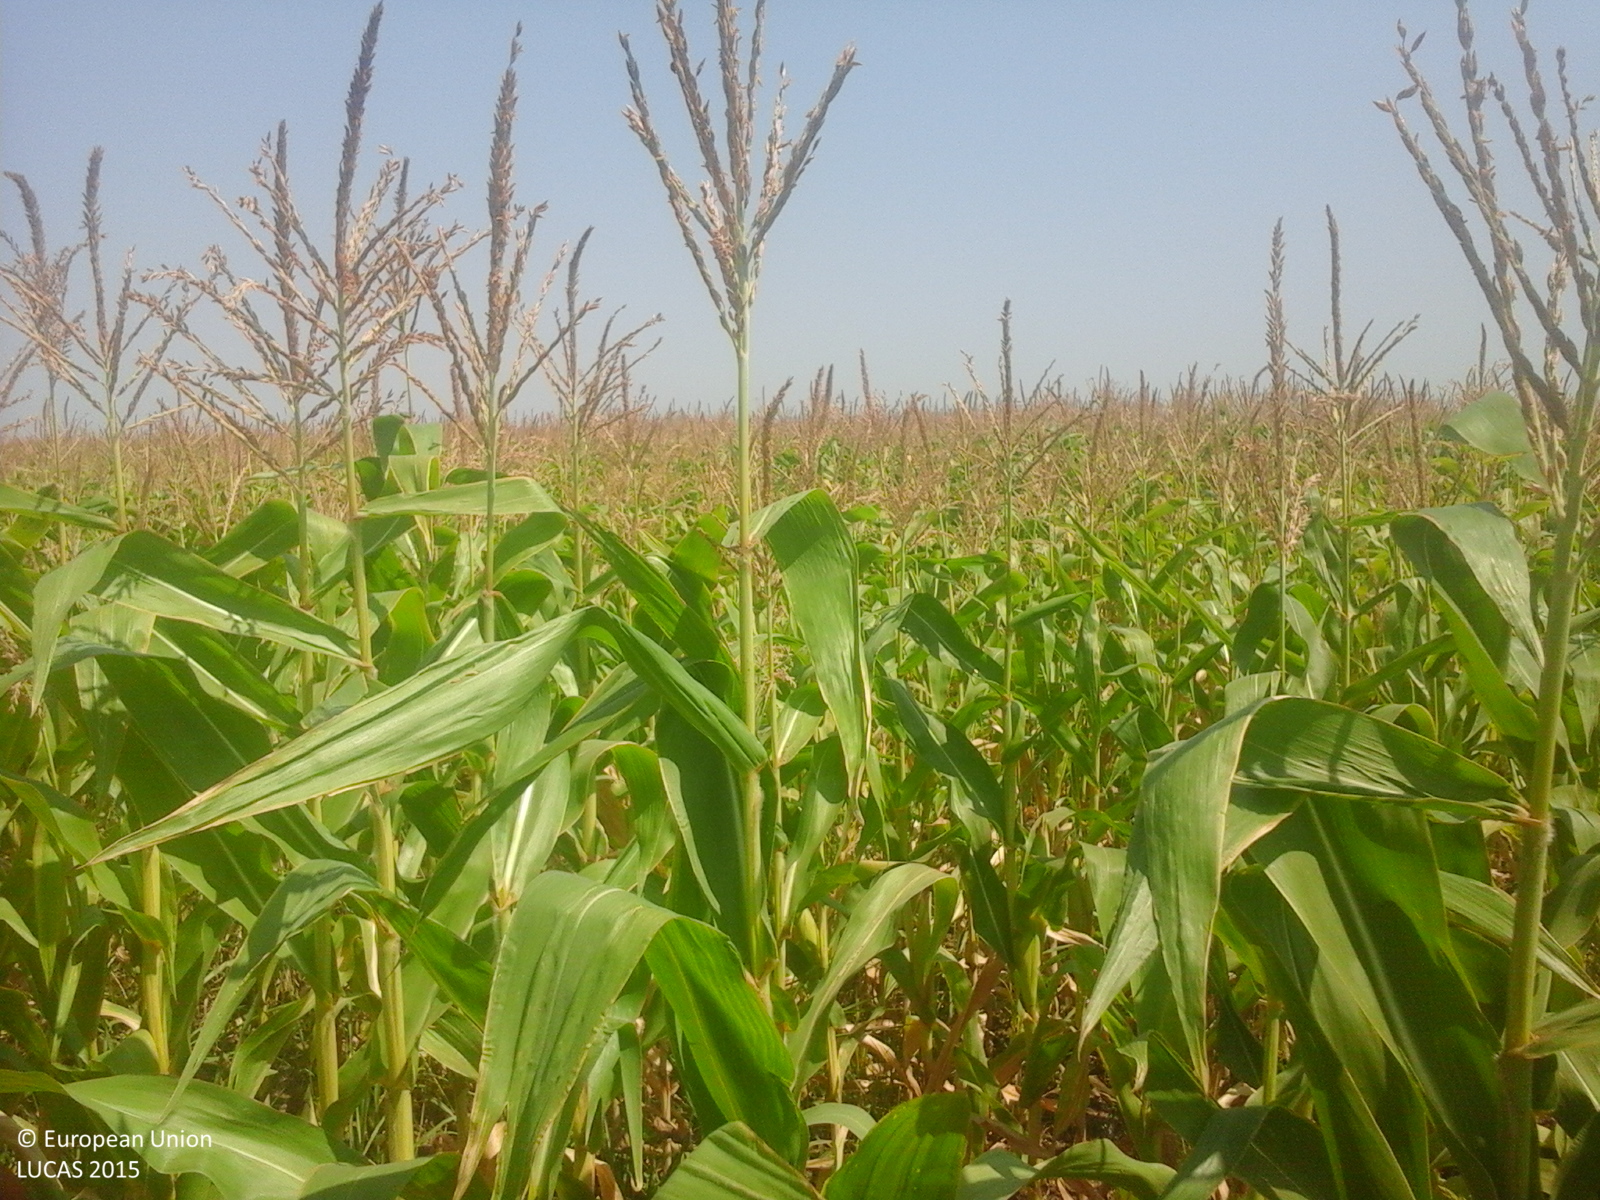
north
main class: Cropland
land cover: Maize
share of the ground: > 75 %
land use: Agriculture (excluding fallow land and kitchen gardens)
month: August
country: RO
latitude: 45.1814
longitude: 27.7582
